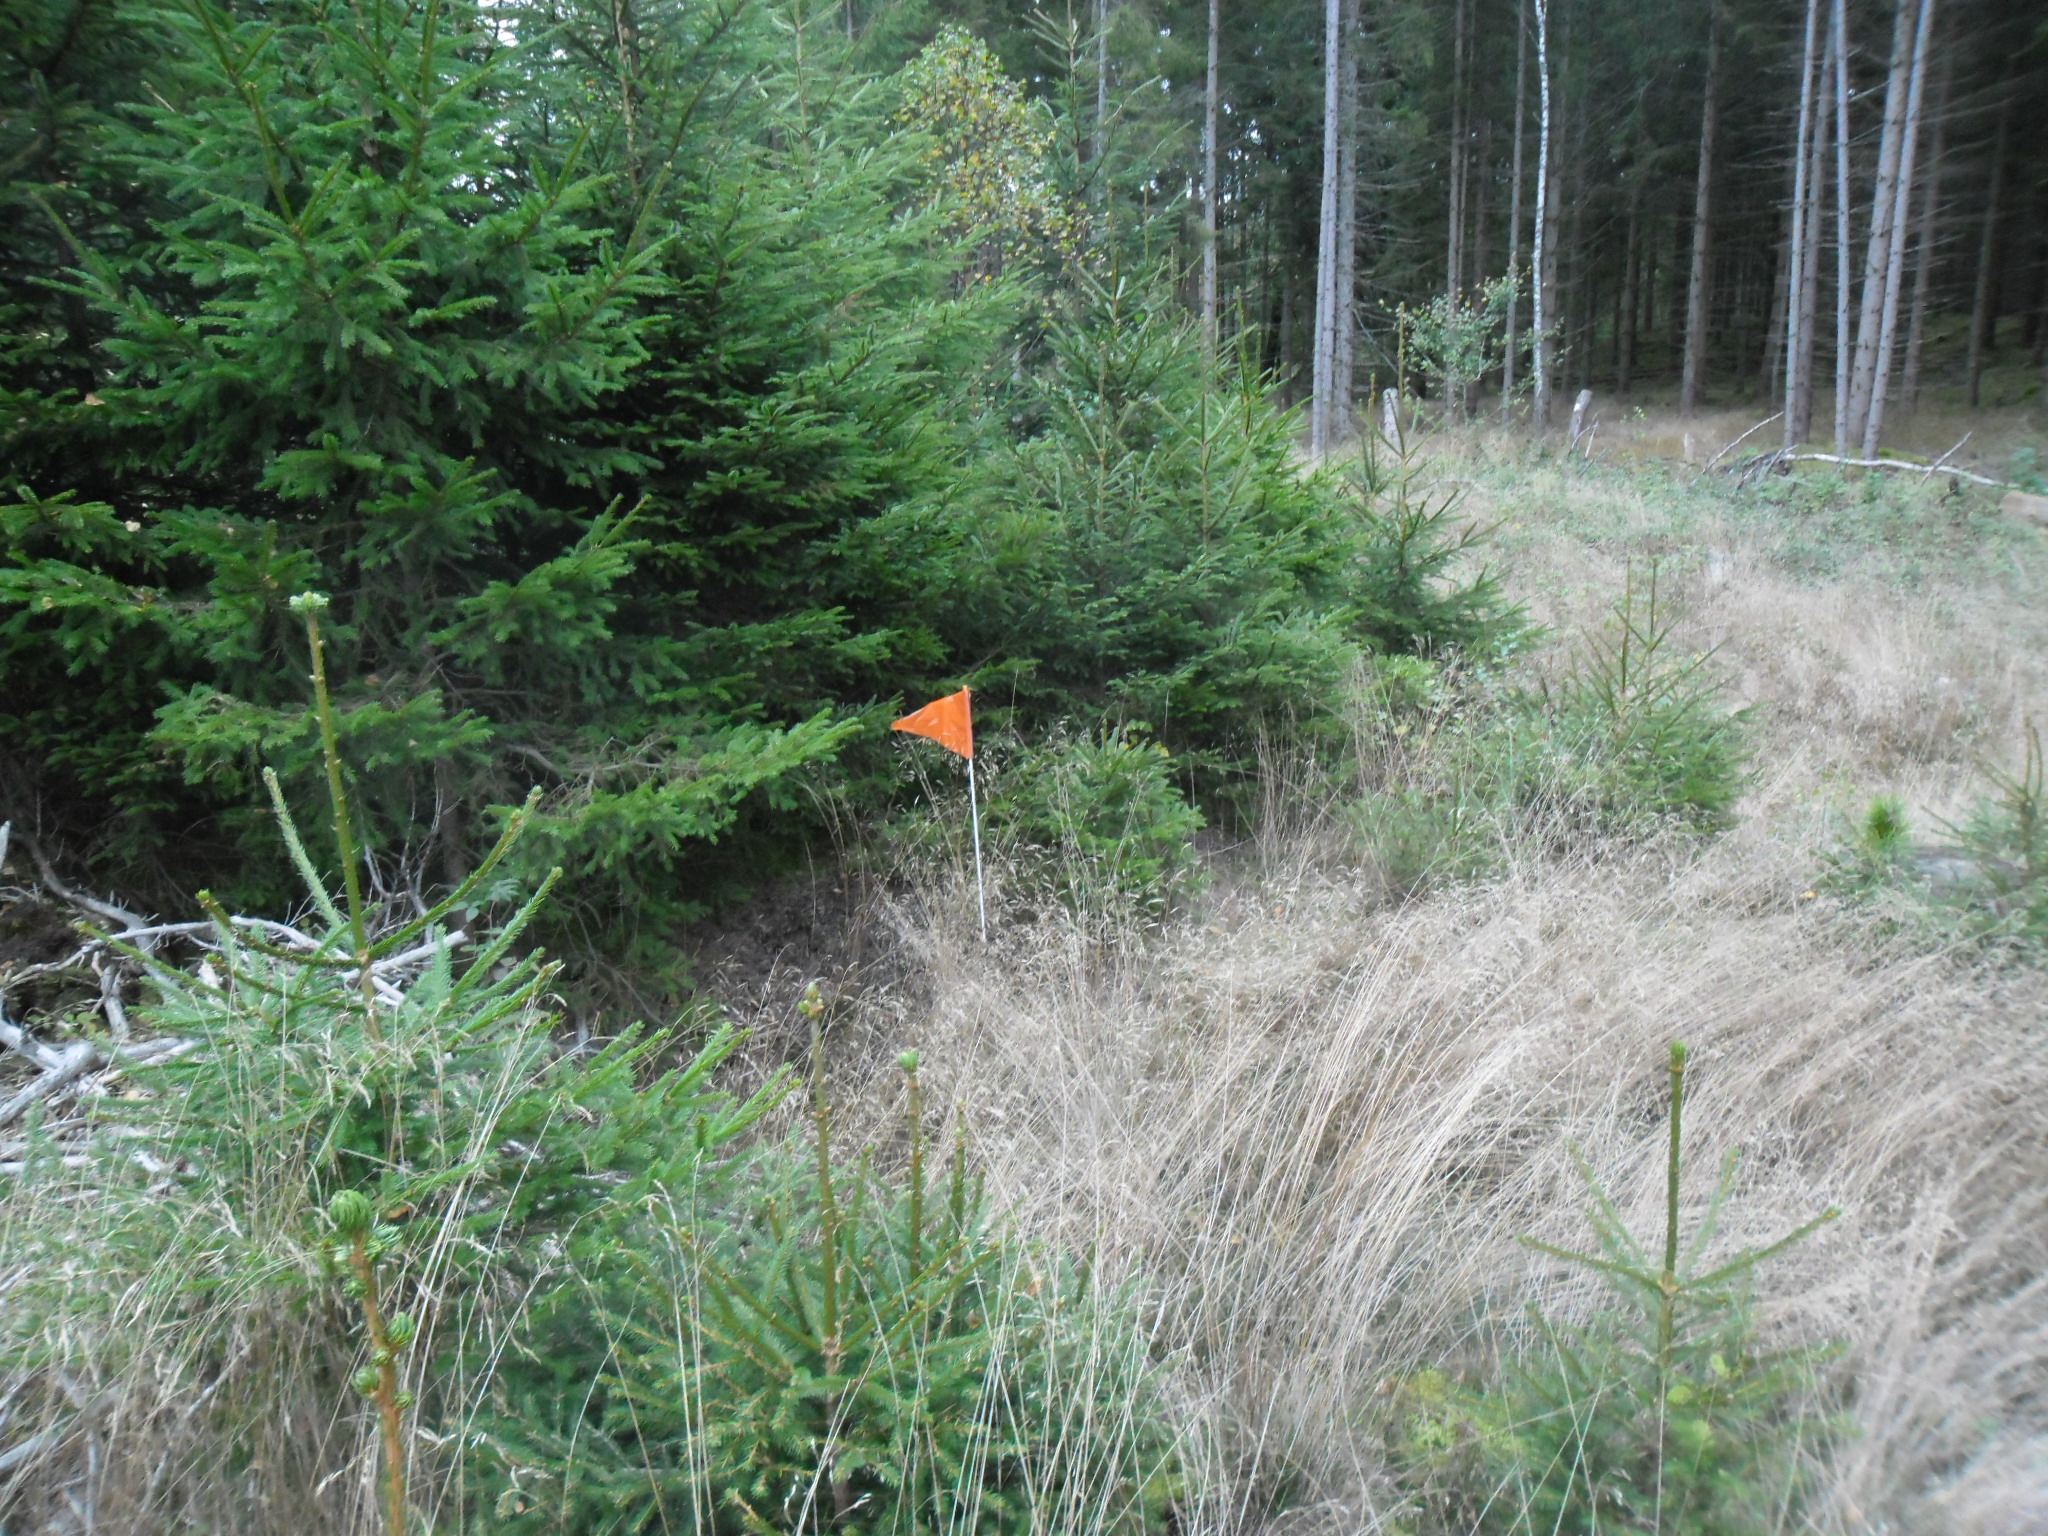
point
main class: Woodland
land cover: Spruce dominated coniferous woodland
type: boreal forest
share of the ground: > 75 %
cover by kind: coniferous forest trees 100 %
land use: Forestry
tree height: > 5 m
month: October
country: SE
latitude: 56.3674
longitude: 13.7368
